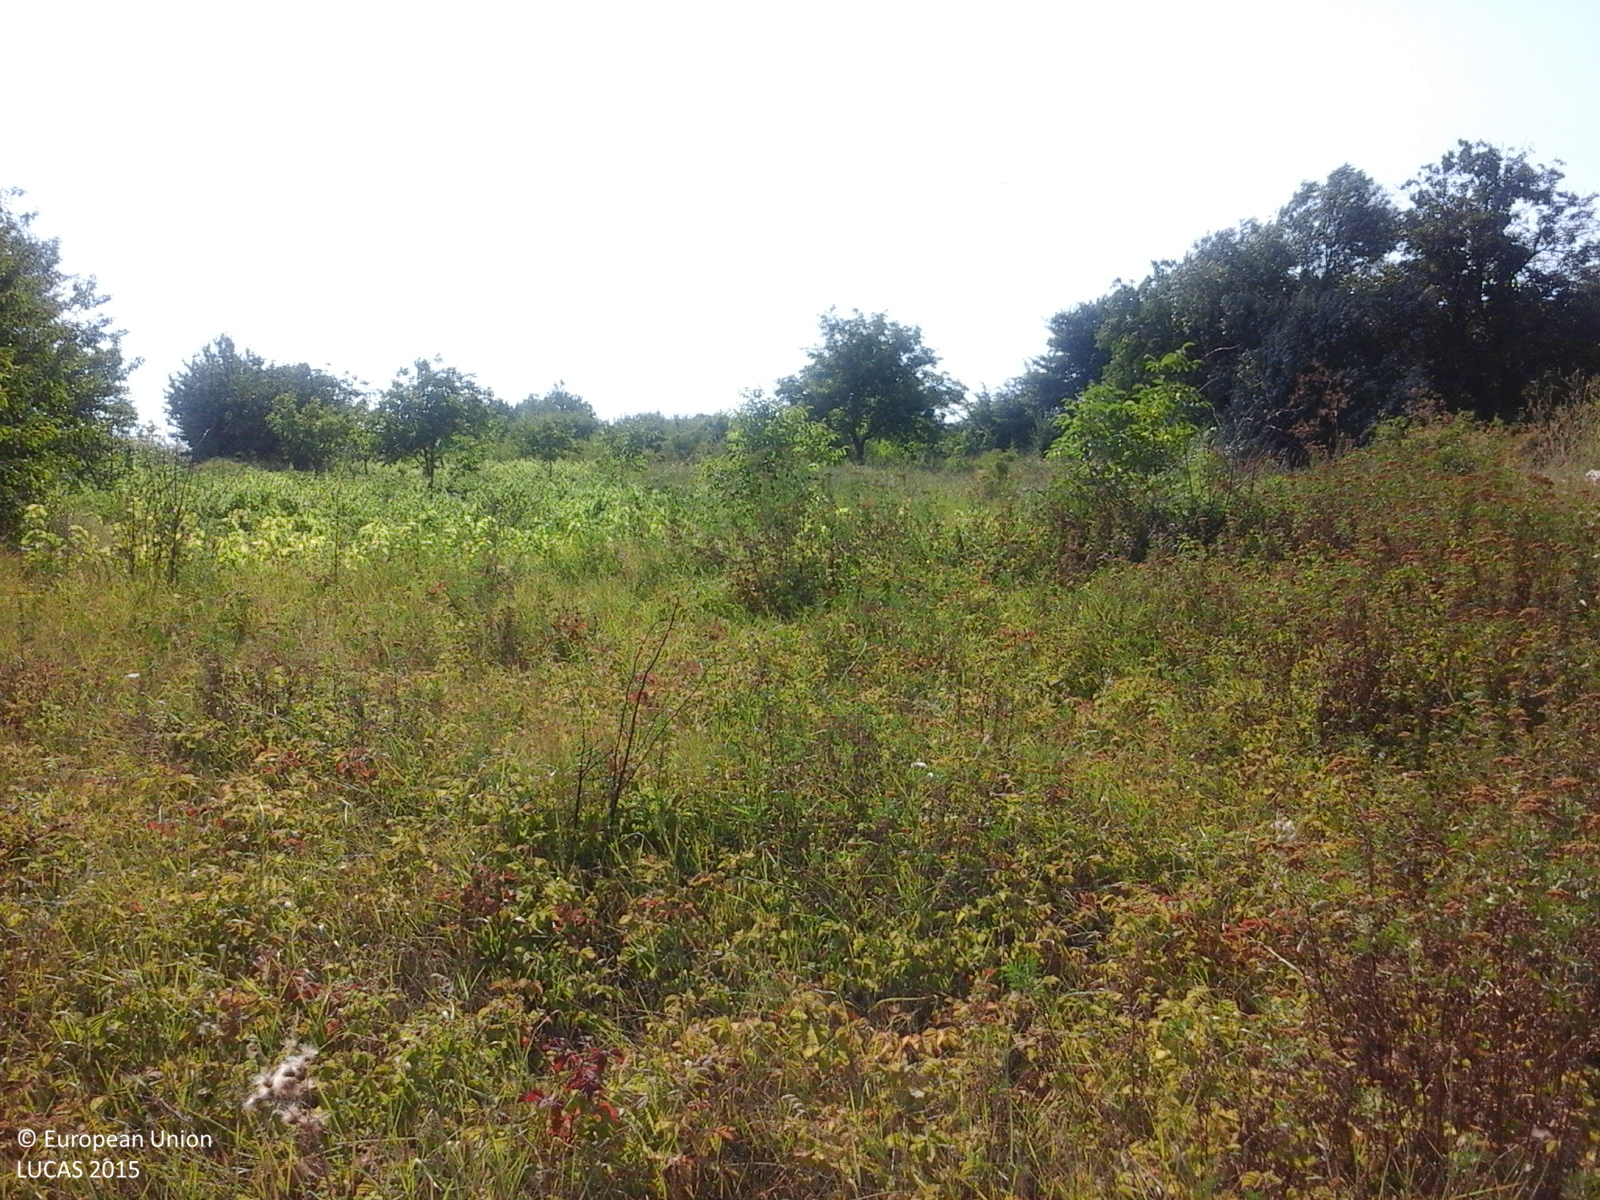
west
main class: Grassland
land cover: Spontaneously vegetated surfaces
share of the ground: > 75 %
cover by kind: herbaceous plants 100 %
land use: Agriculture (excluding fallow land and kitchen gardens)
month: July
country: RO
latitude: 46.2635
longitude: 27.3469
